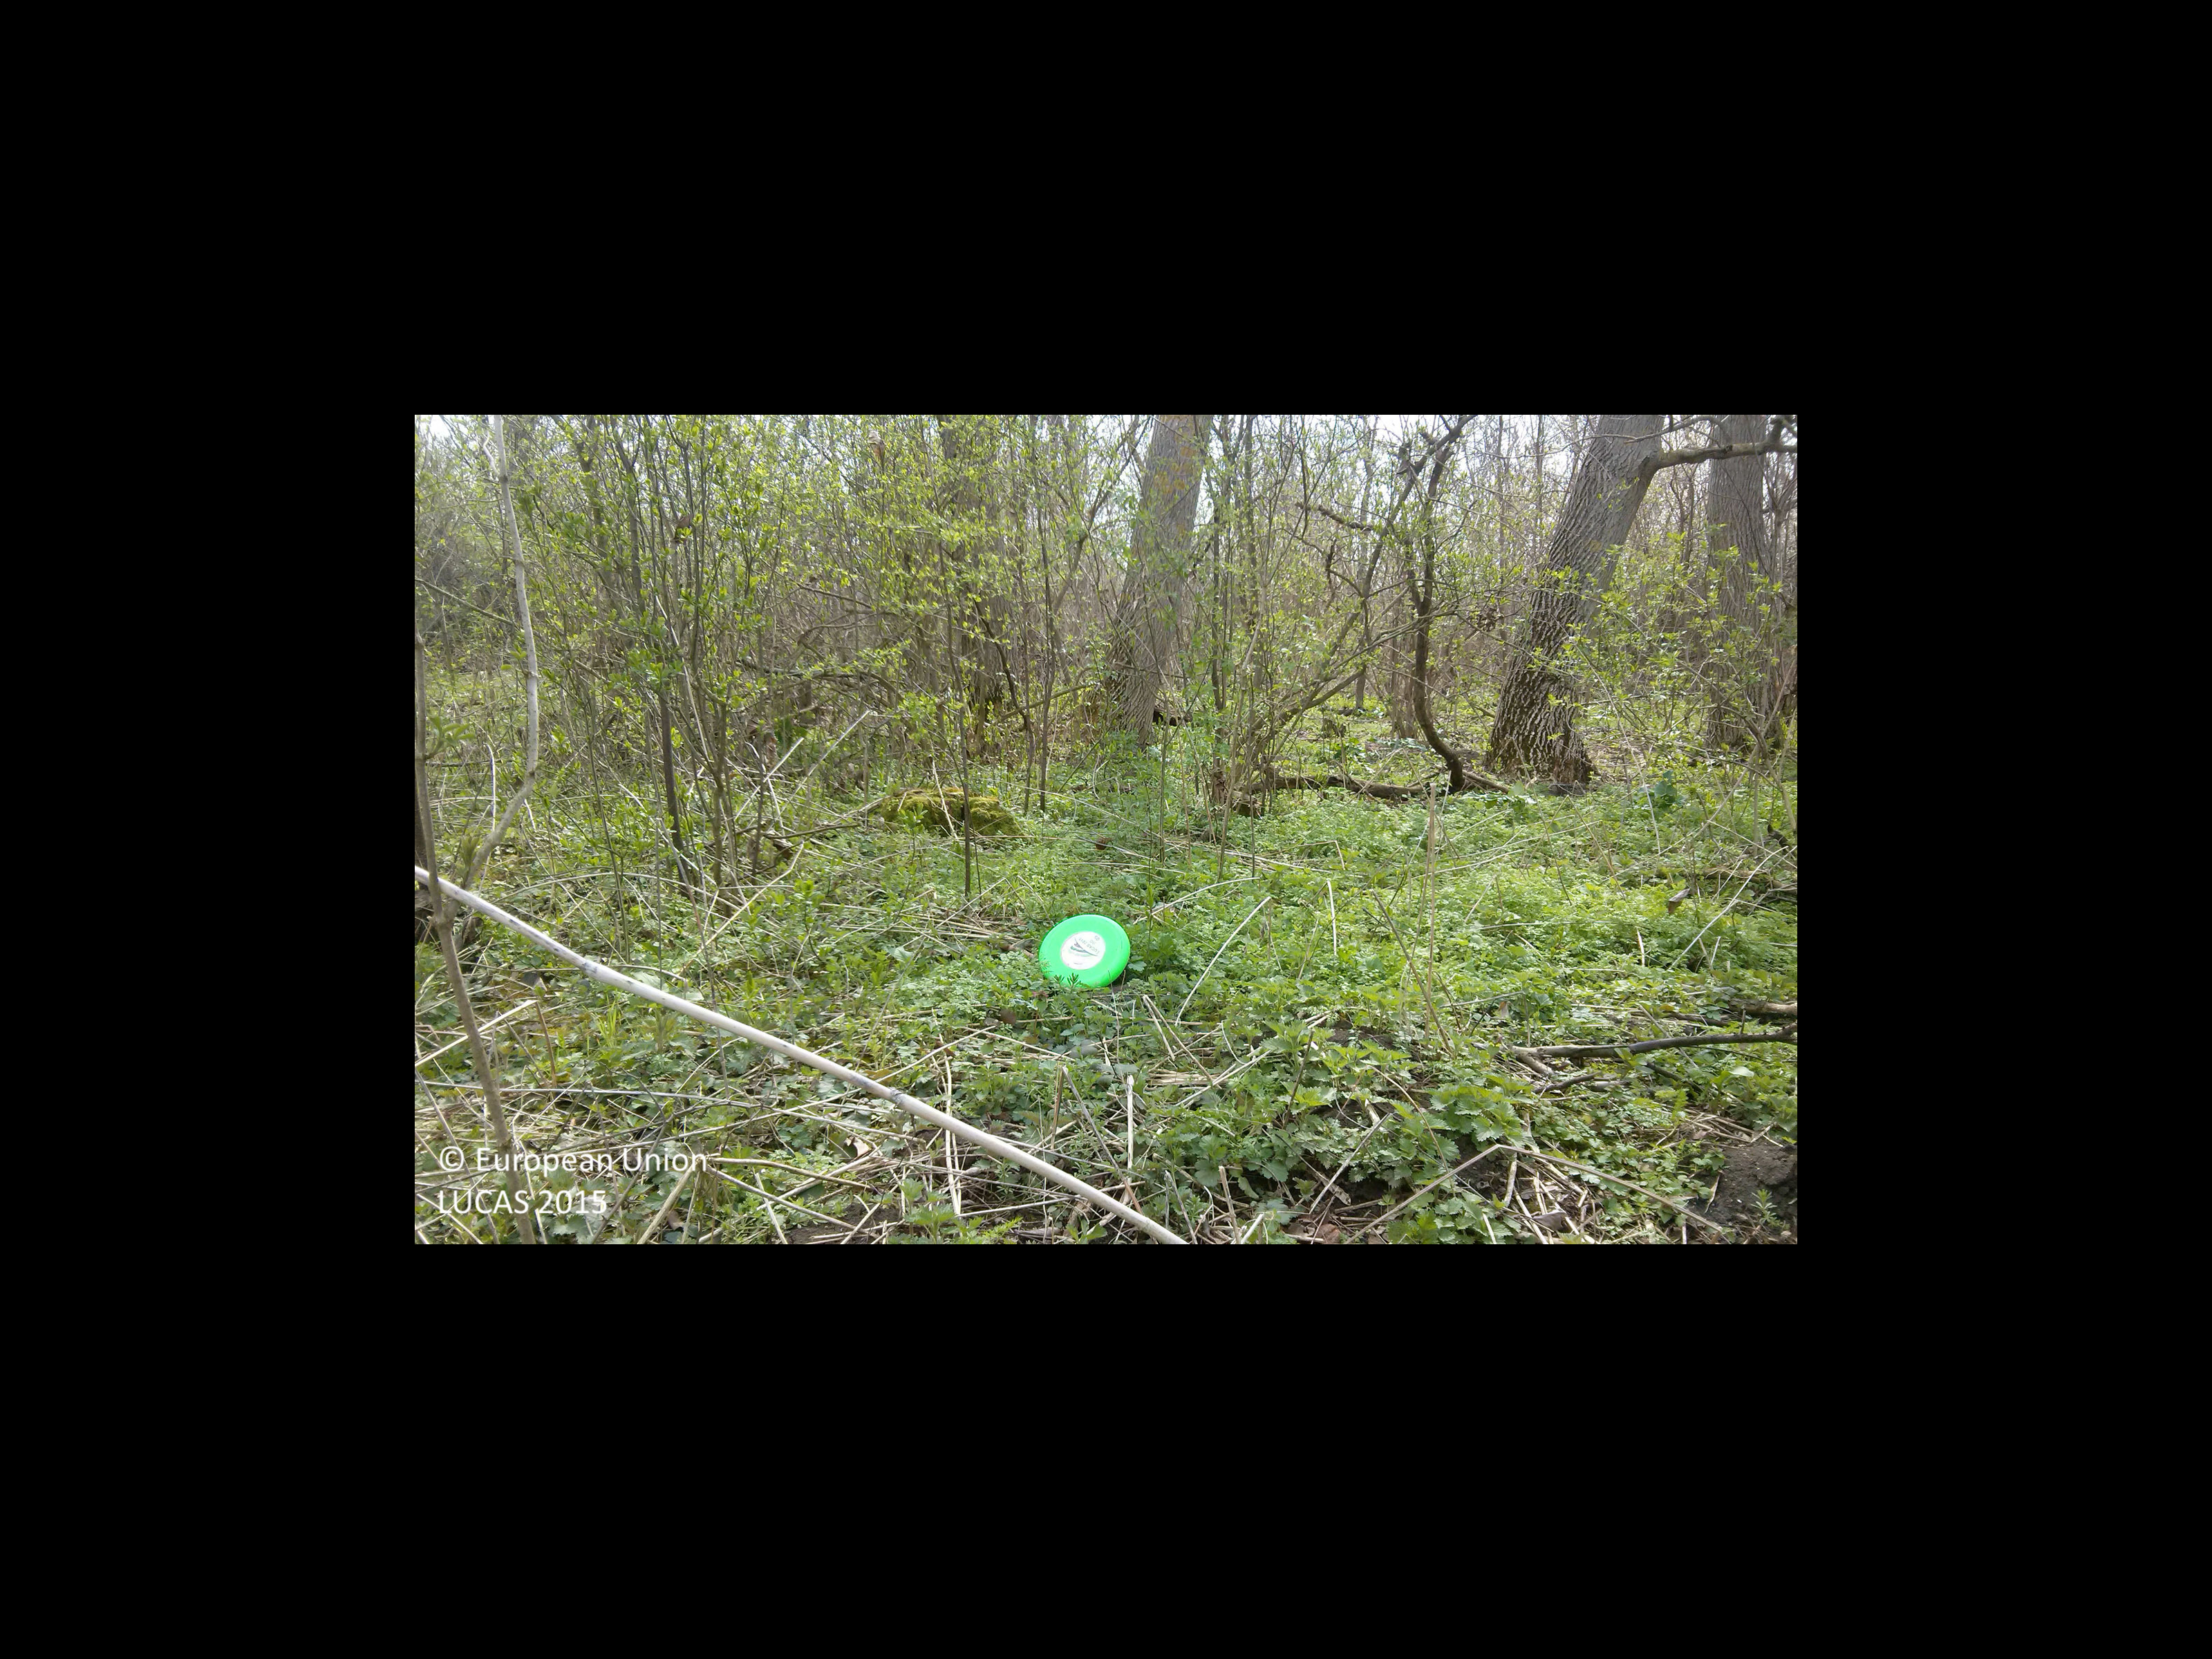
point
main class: Woodland
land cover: Broadleaved woodland
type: mesophytic deciduous forest
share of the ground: > 75 %
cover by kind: broadleaved forest trees 90 %, shrubs 10 %
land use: Forestry
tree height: > 5 m
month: June
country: BG
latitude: 43.3304
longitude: 26.9485
